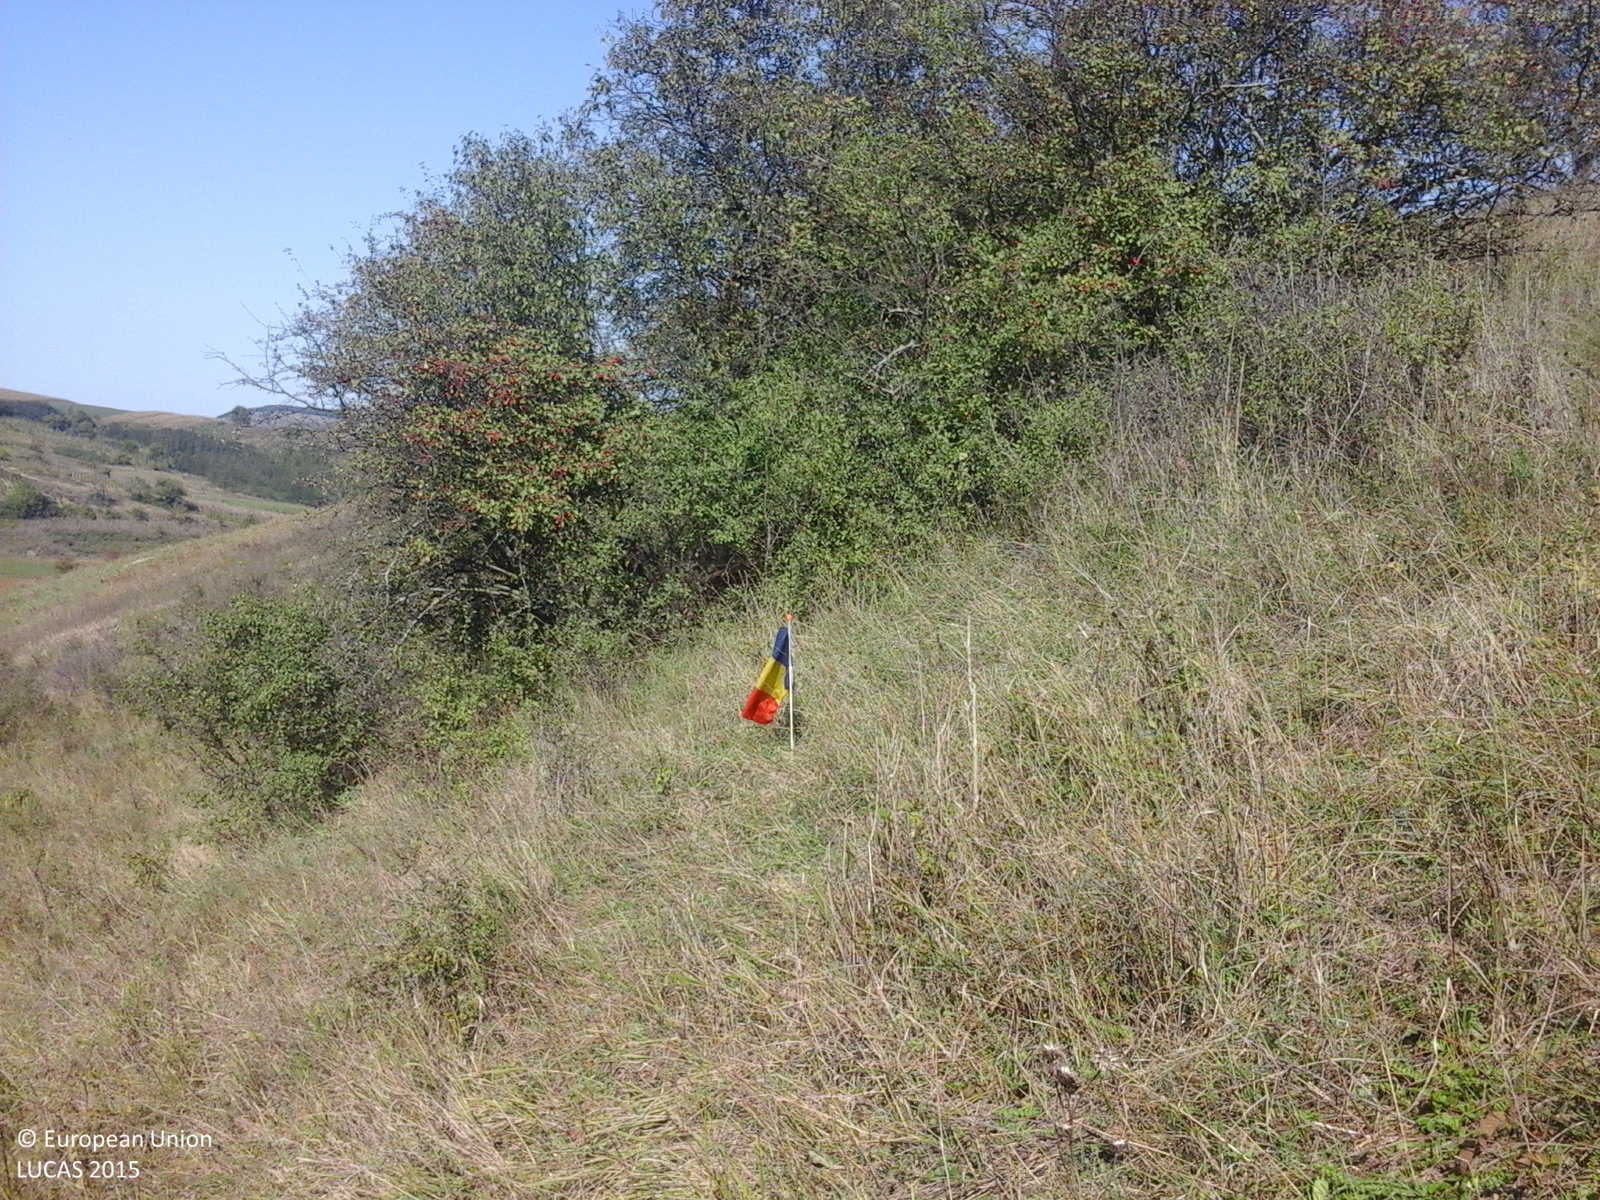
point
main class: Grassland
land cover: Grassland with sparse tree/shrub cover
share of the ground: > 75 %
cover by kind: herbaceous plants 85 %, shrubs 10 %, broadleaved forest trees 5 %
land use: Fallow land
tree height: < 5 m
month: October
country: RO
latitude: 46.2715
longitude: 23.8135
